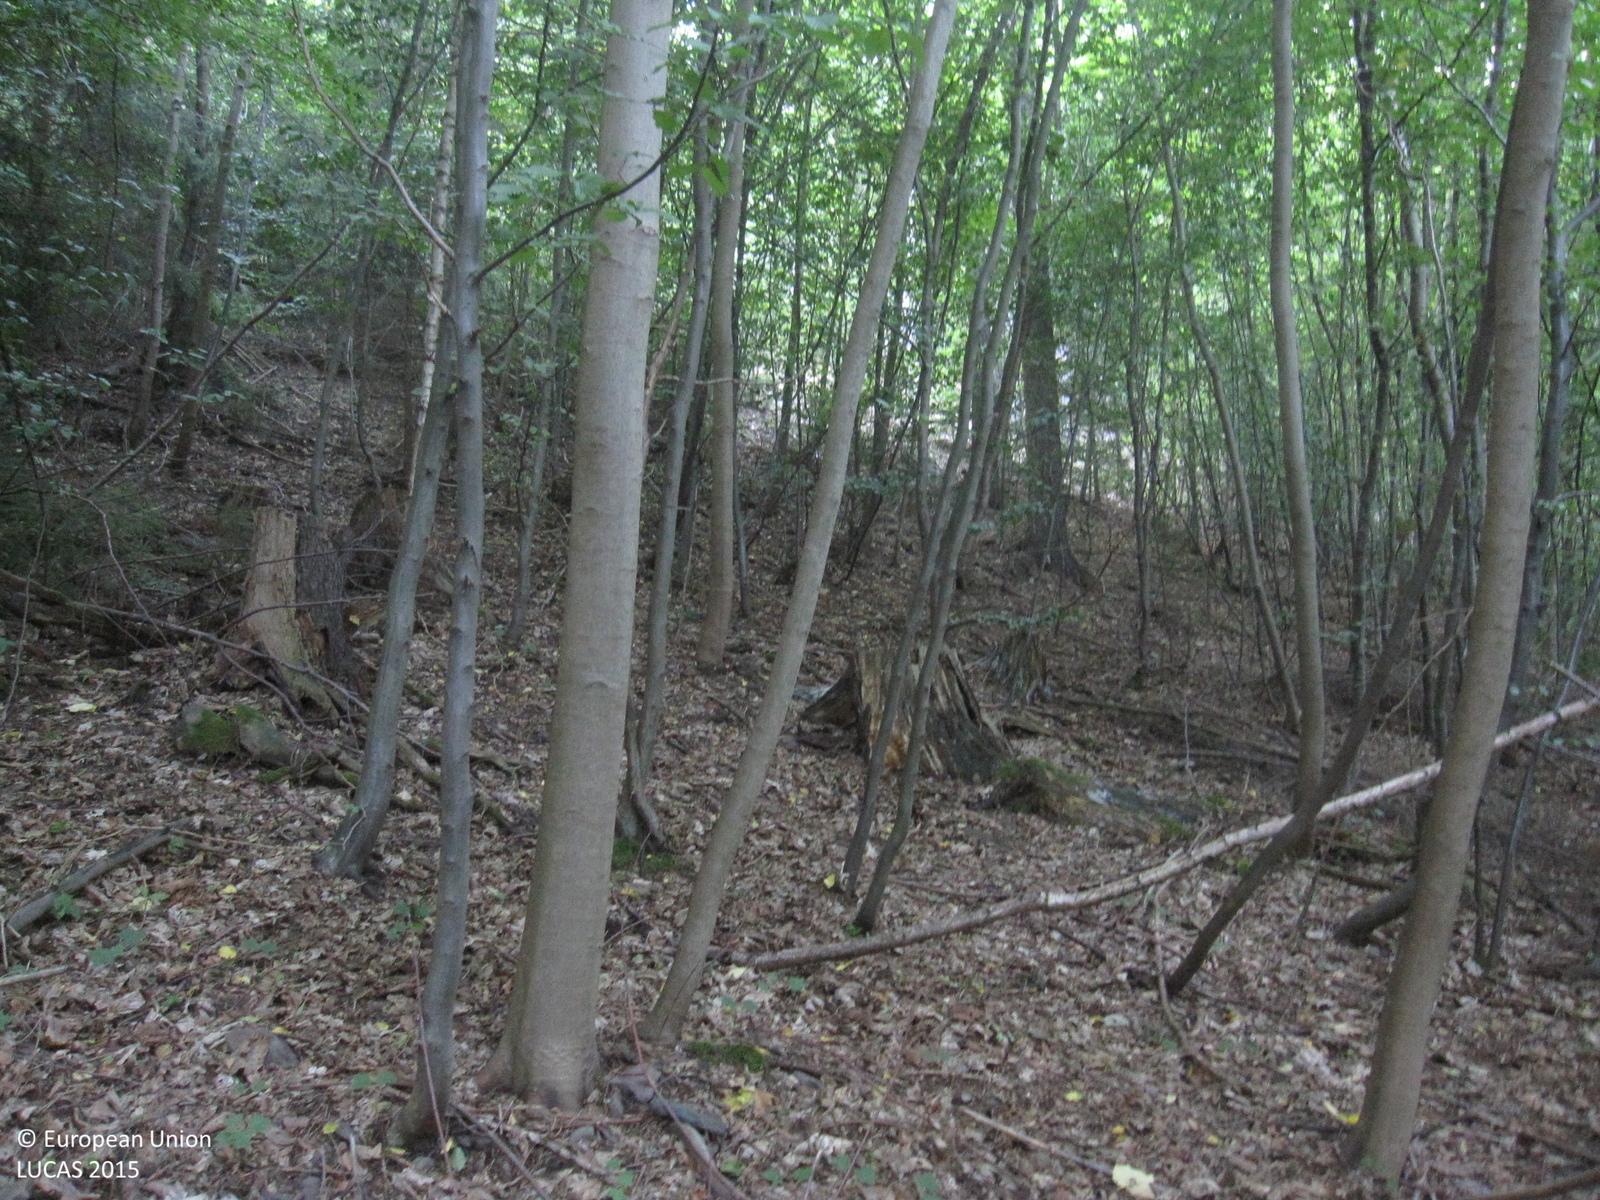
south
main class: Woodland
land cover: Broadleaved woodland
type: beech forest
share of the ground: > 75 %
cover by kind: broadleaved forest trees 95 %, unconsolidated bare surface 5 %
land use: Forestry
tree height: > 5 m
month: August
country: DE
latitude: 50.6058
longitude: 11.5115
